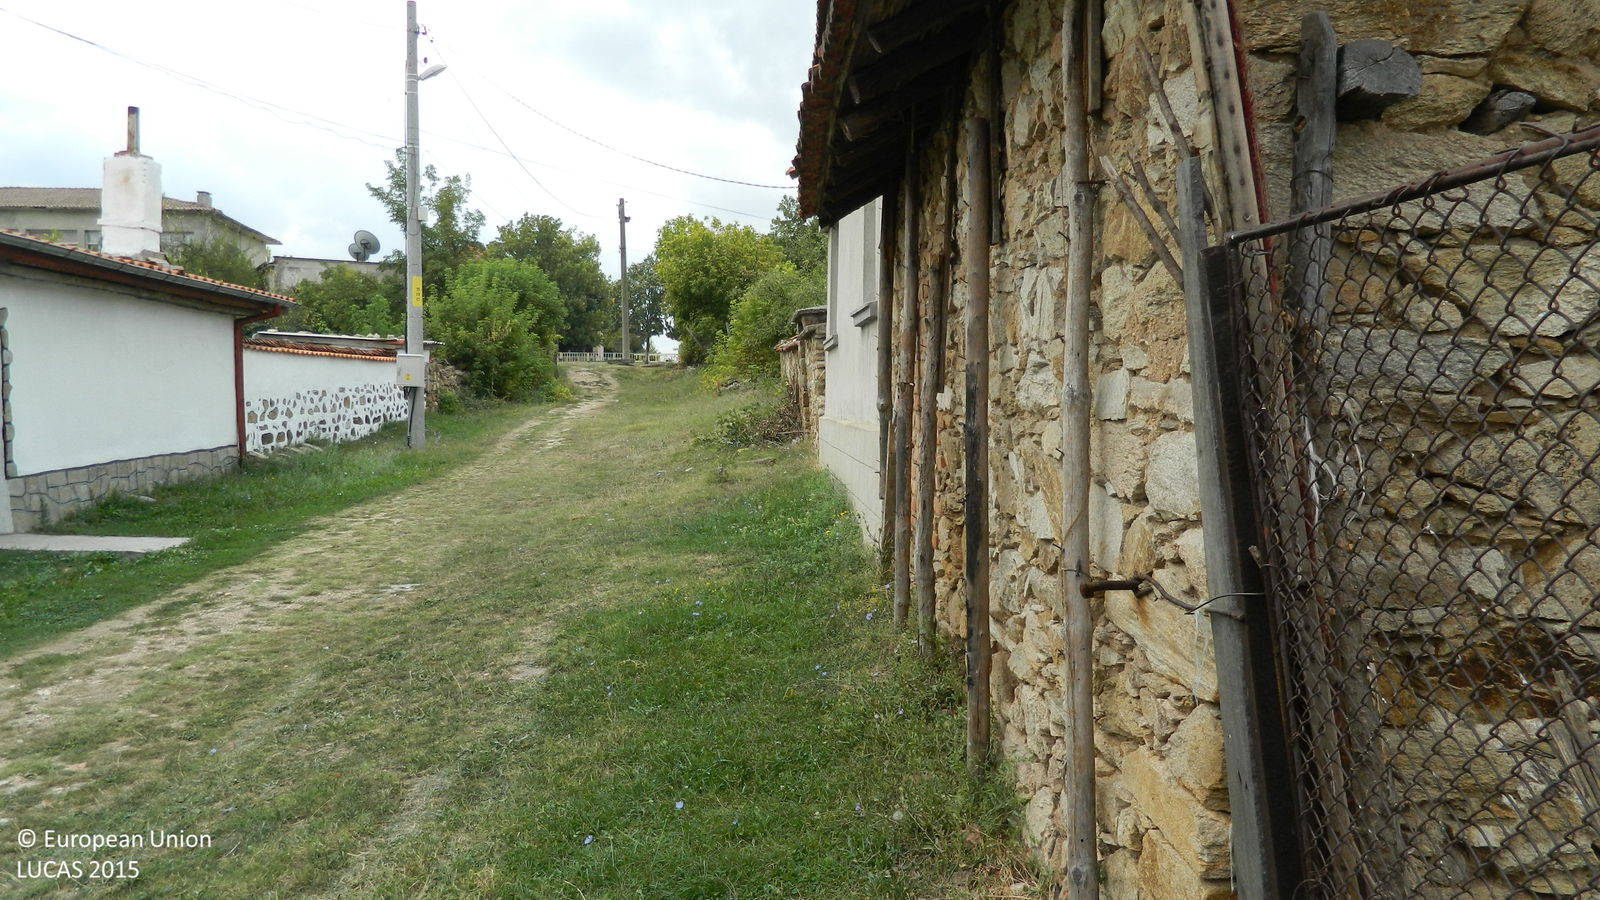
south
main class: Grassland
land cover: Grassland without tree/shrub cover
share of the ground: > 75 %
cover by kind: herbaceous plants 95 %, unconsolidated bare surface 5 %
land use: Residential
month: September
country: BG
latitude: 41.8416
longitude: 25.7100
